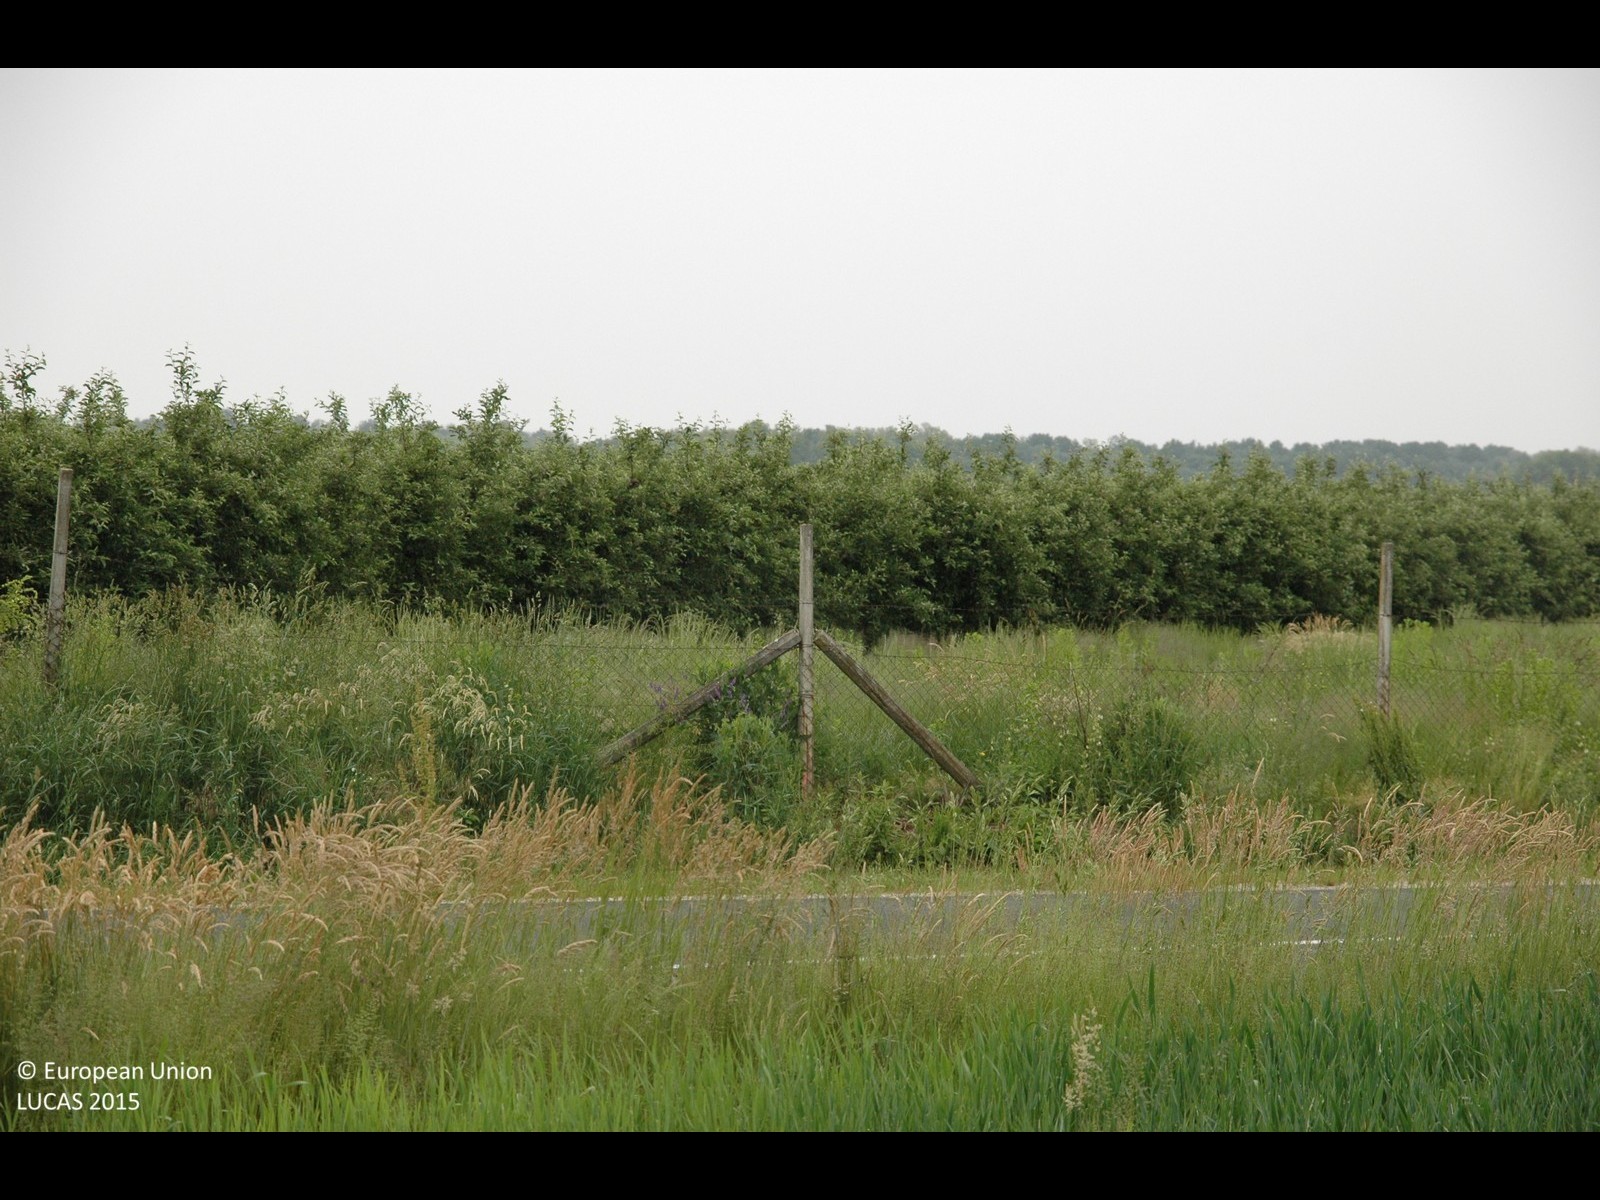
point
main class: Cropland
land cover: Apple fruit
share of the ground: 50 - 75 %
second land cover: Grassland without tree/shrub cover
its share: 50 - 75 %
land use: Agriculture (excluding fallow land and kitchen gardens)
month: May
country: HR
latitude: 46.4638
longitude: 16.4466
